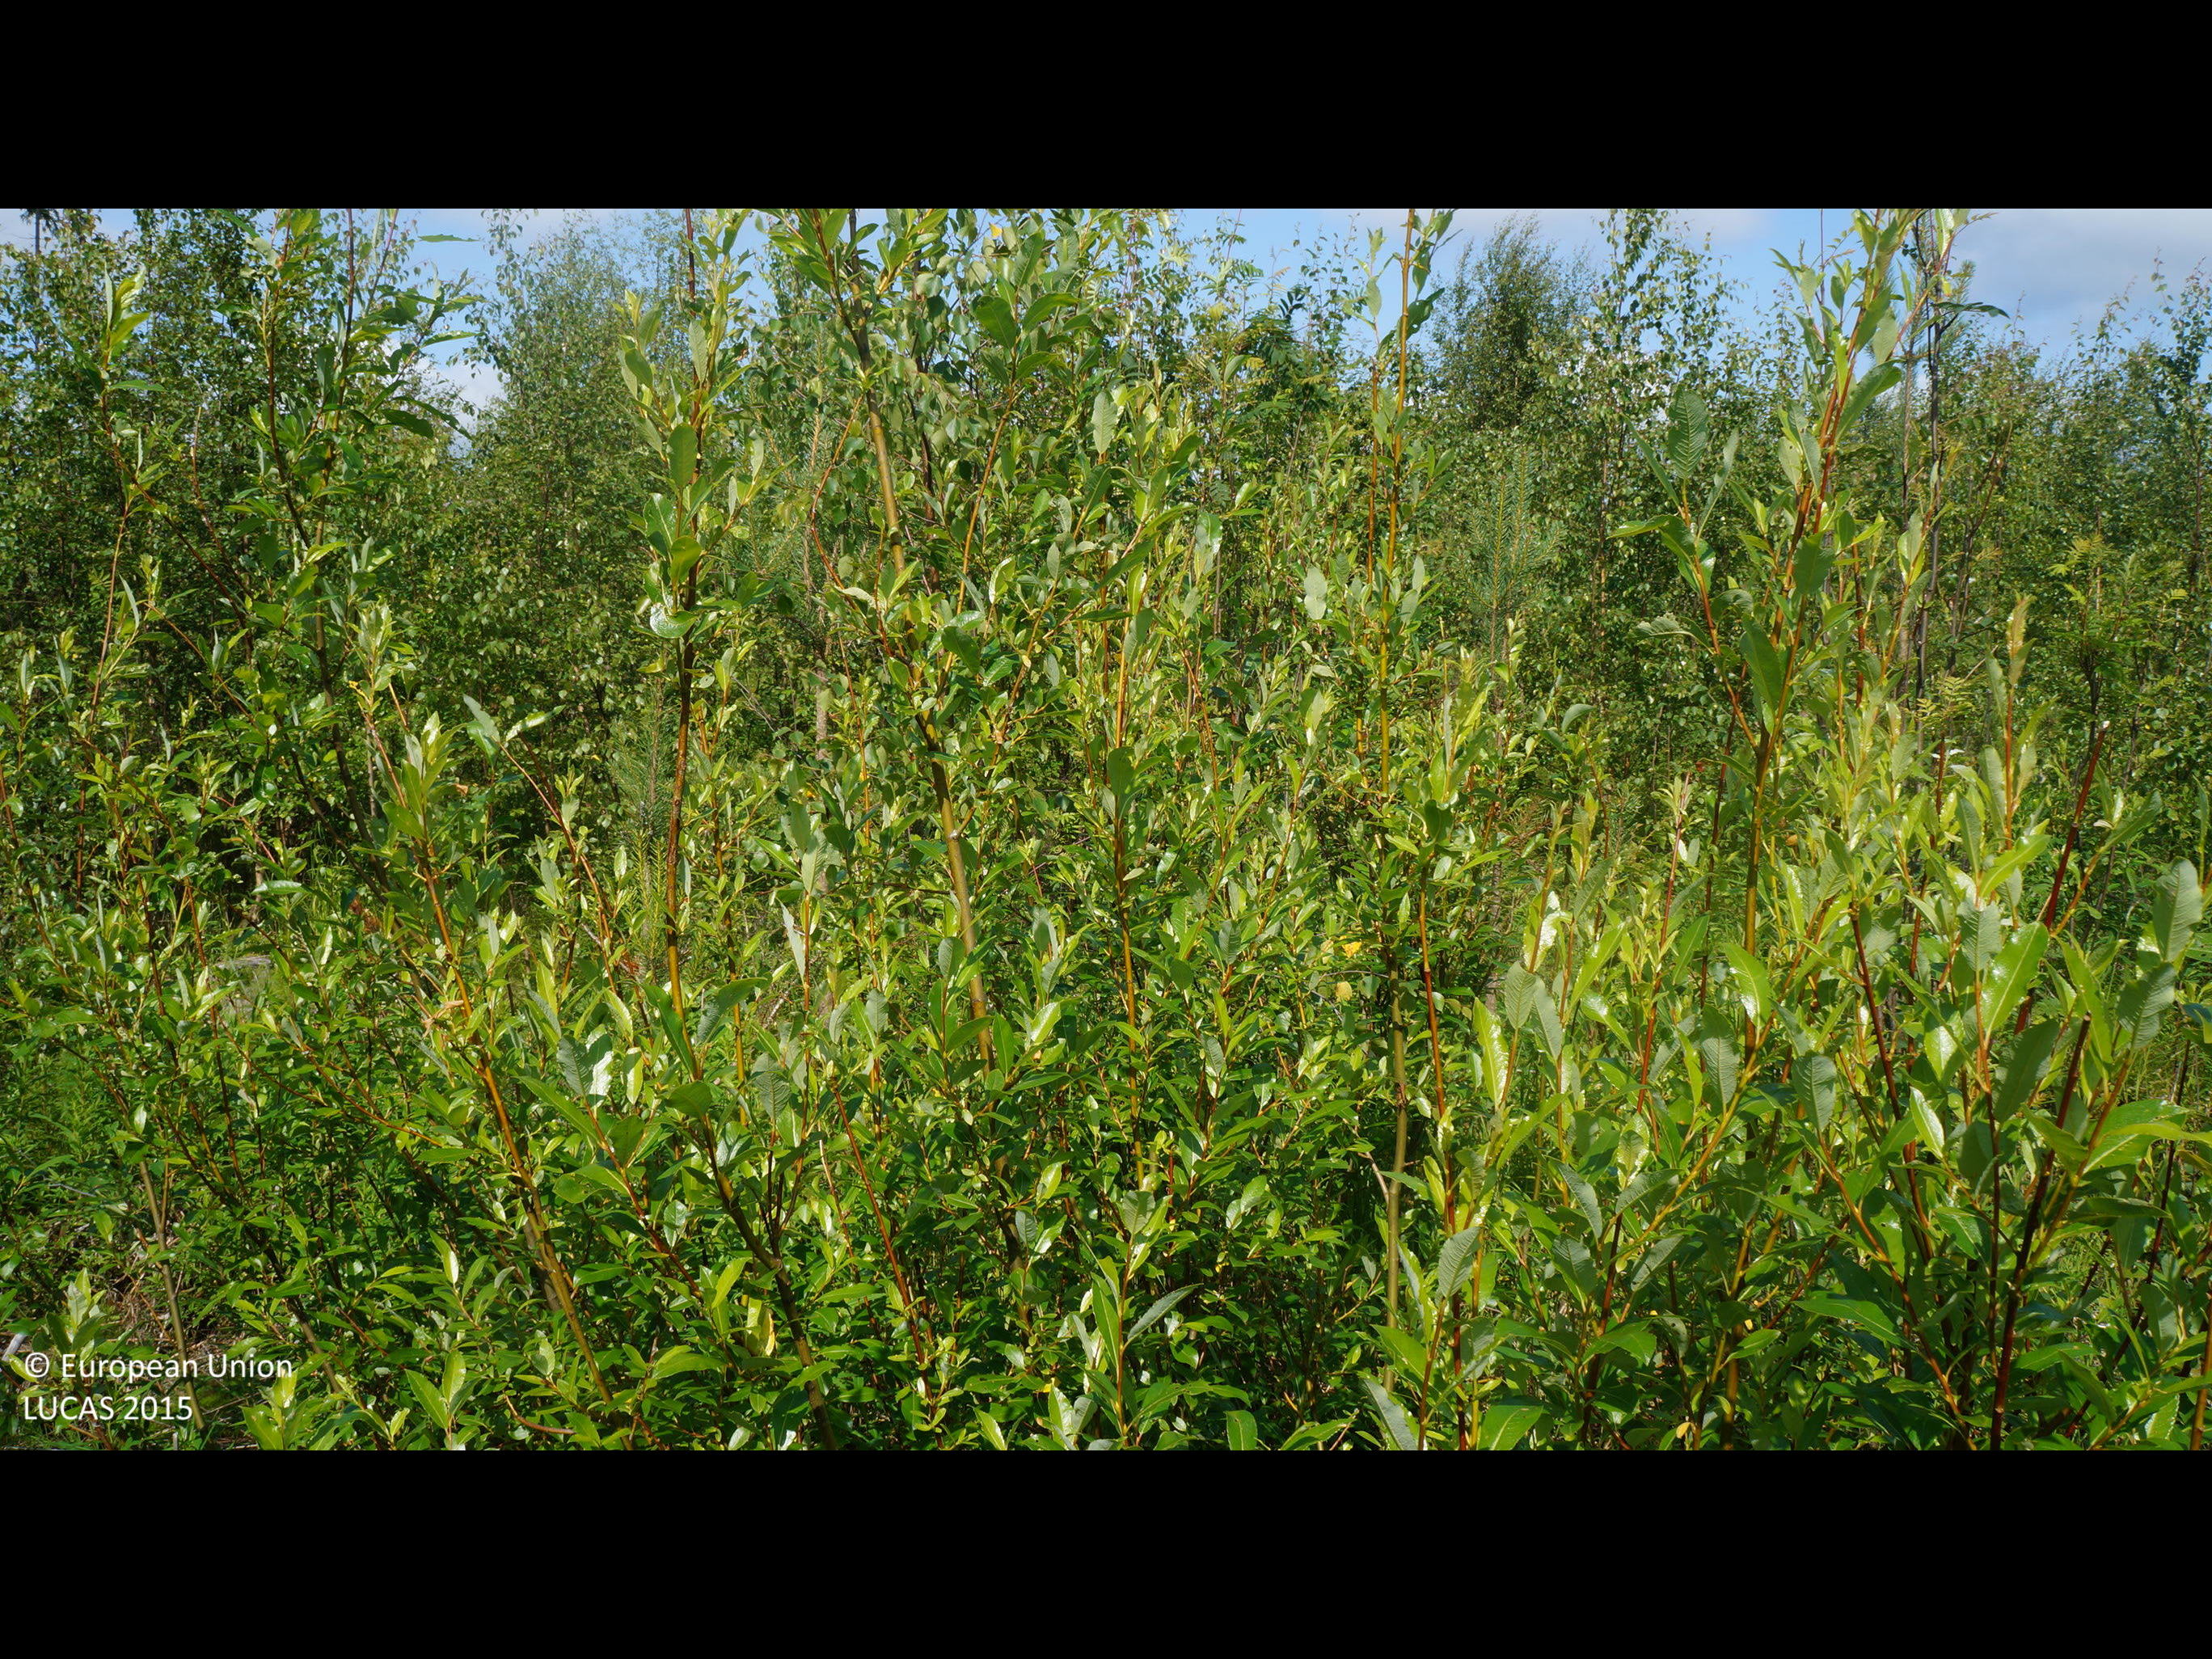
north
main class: Woodland
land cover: Broadleaved woodland
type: boreal forest
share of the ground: 25 - 50 %
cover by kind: shrubs 50 %, broadleaved forest trees 30 %, coniferous forest trees 10 %, herbaceous plants 10 %
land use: Forestry
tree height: < 5 m
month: July
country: FI
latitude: 64.1953
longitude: 24.4220
